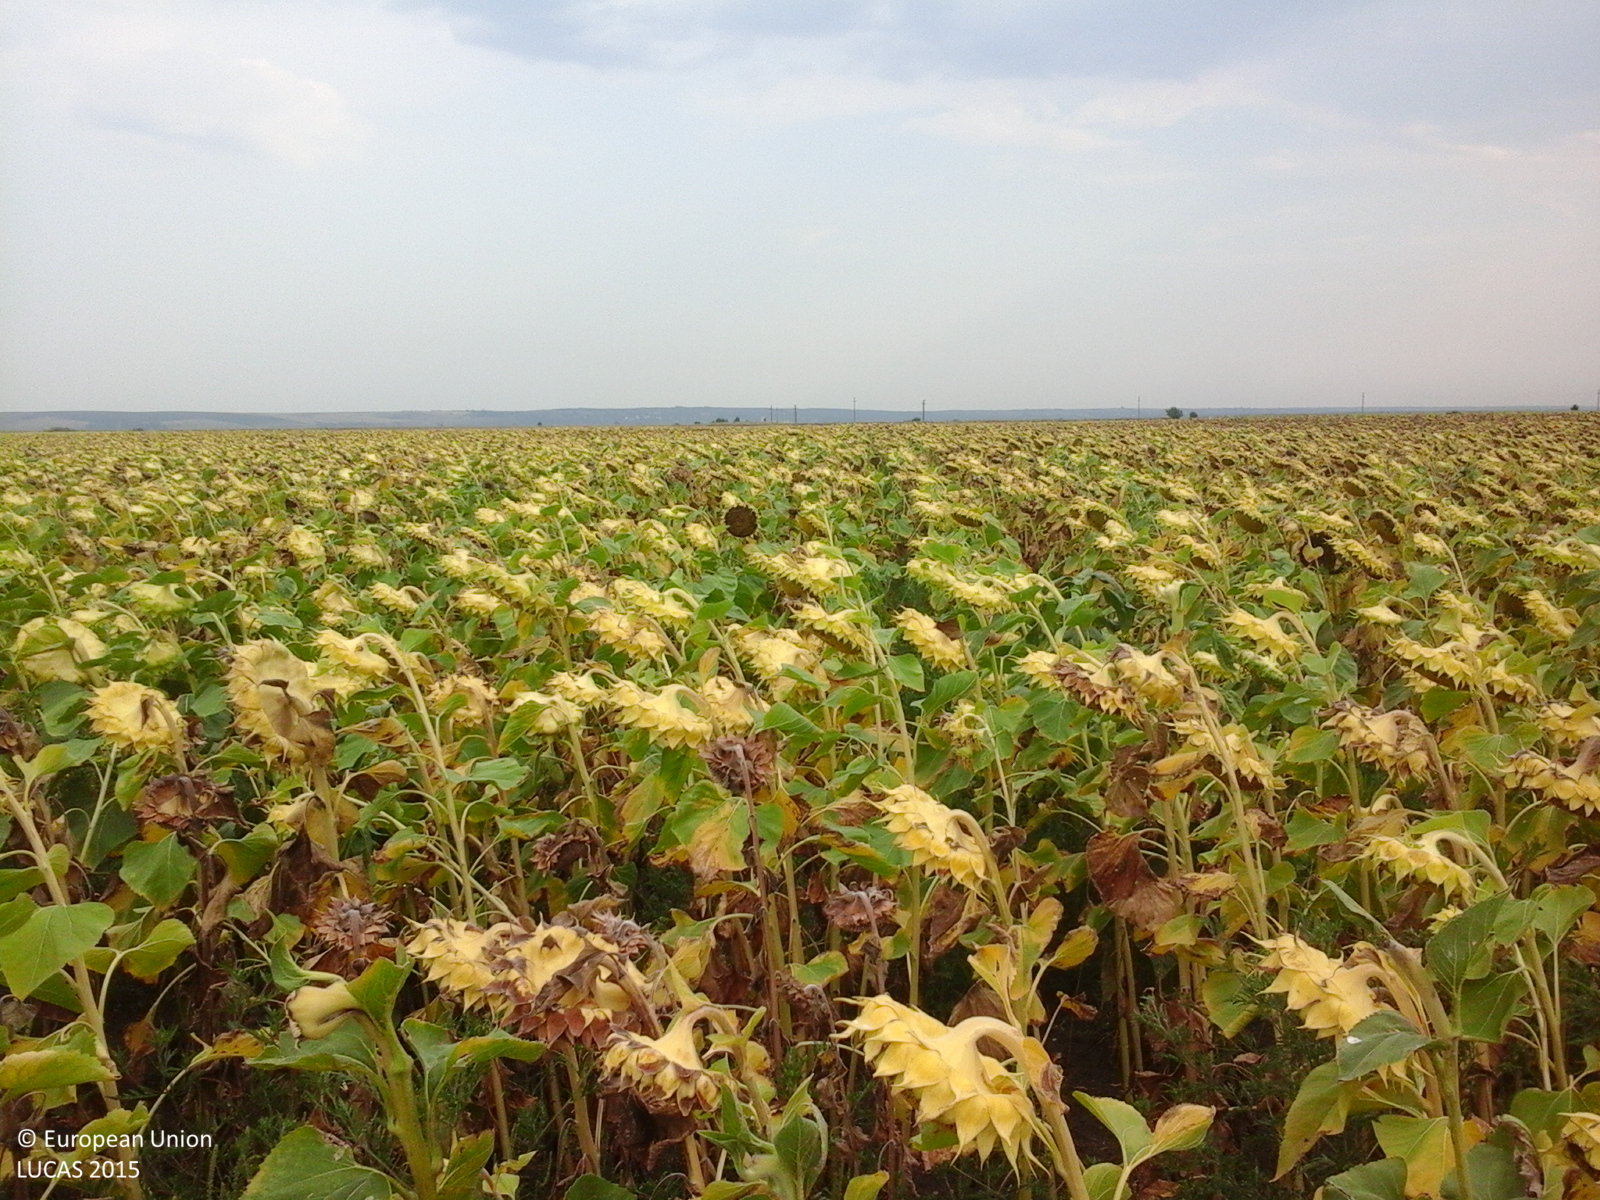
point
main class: Cropland
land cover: Sunflower
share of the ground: > 75 %
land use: Agriculture (excluding fallow land and kitchen gardens)
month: August
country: RO
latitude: 44.4099
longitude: 22.8132
